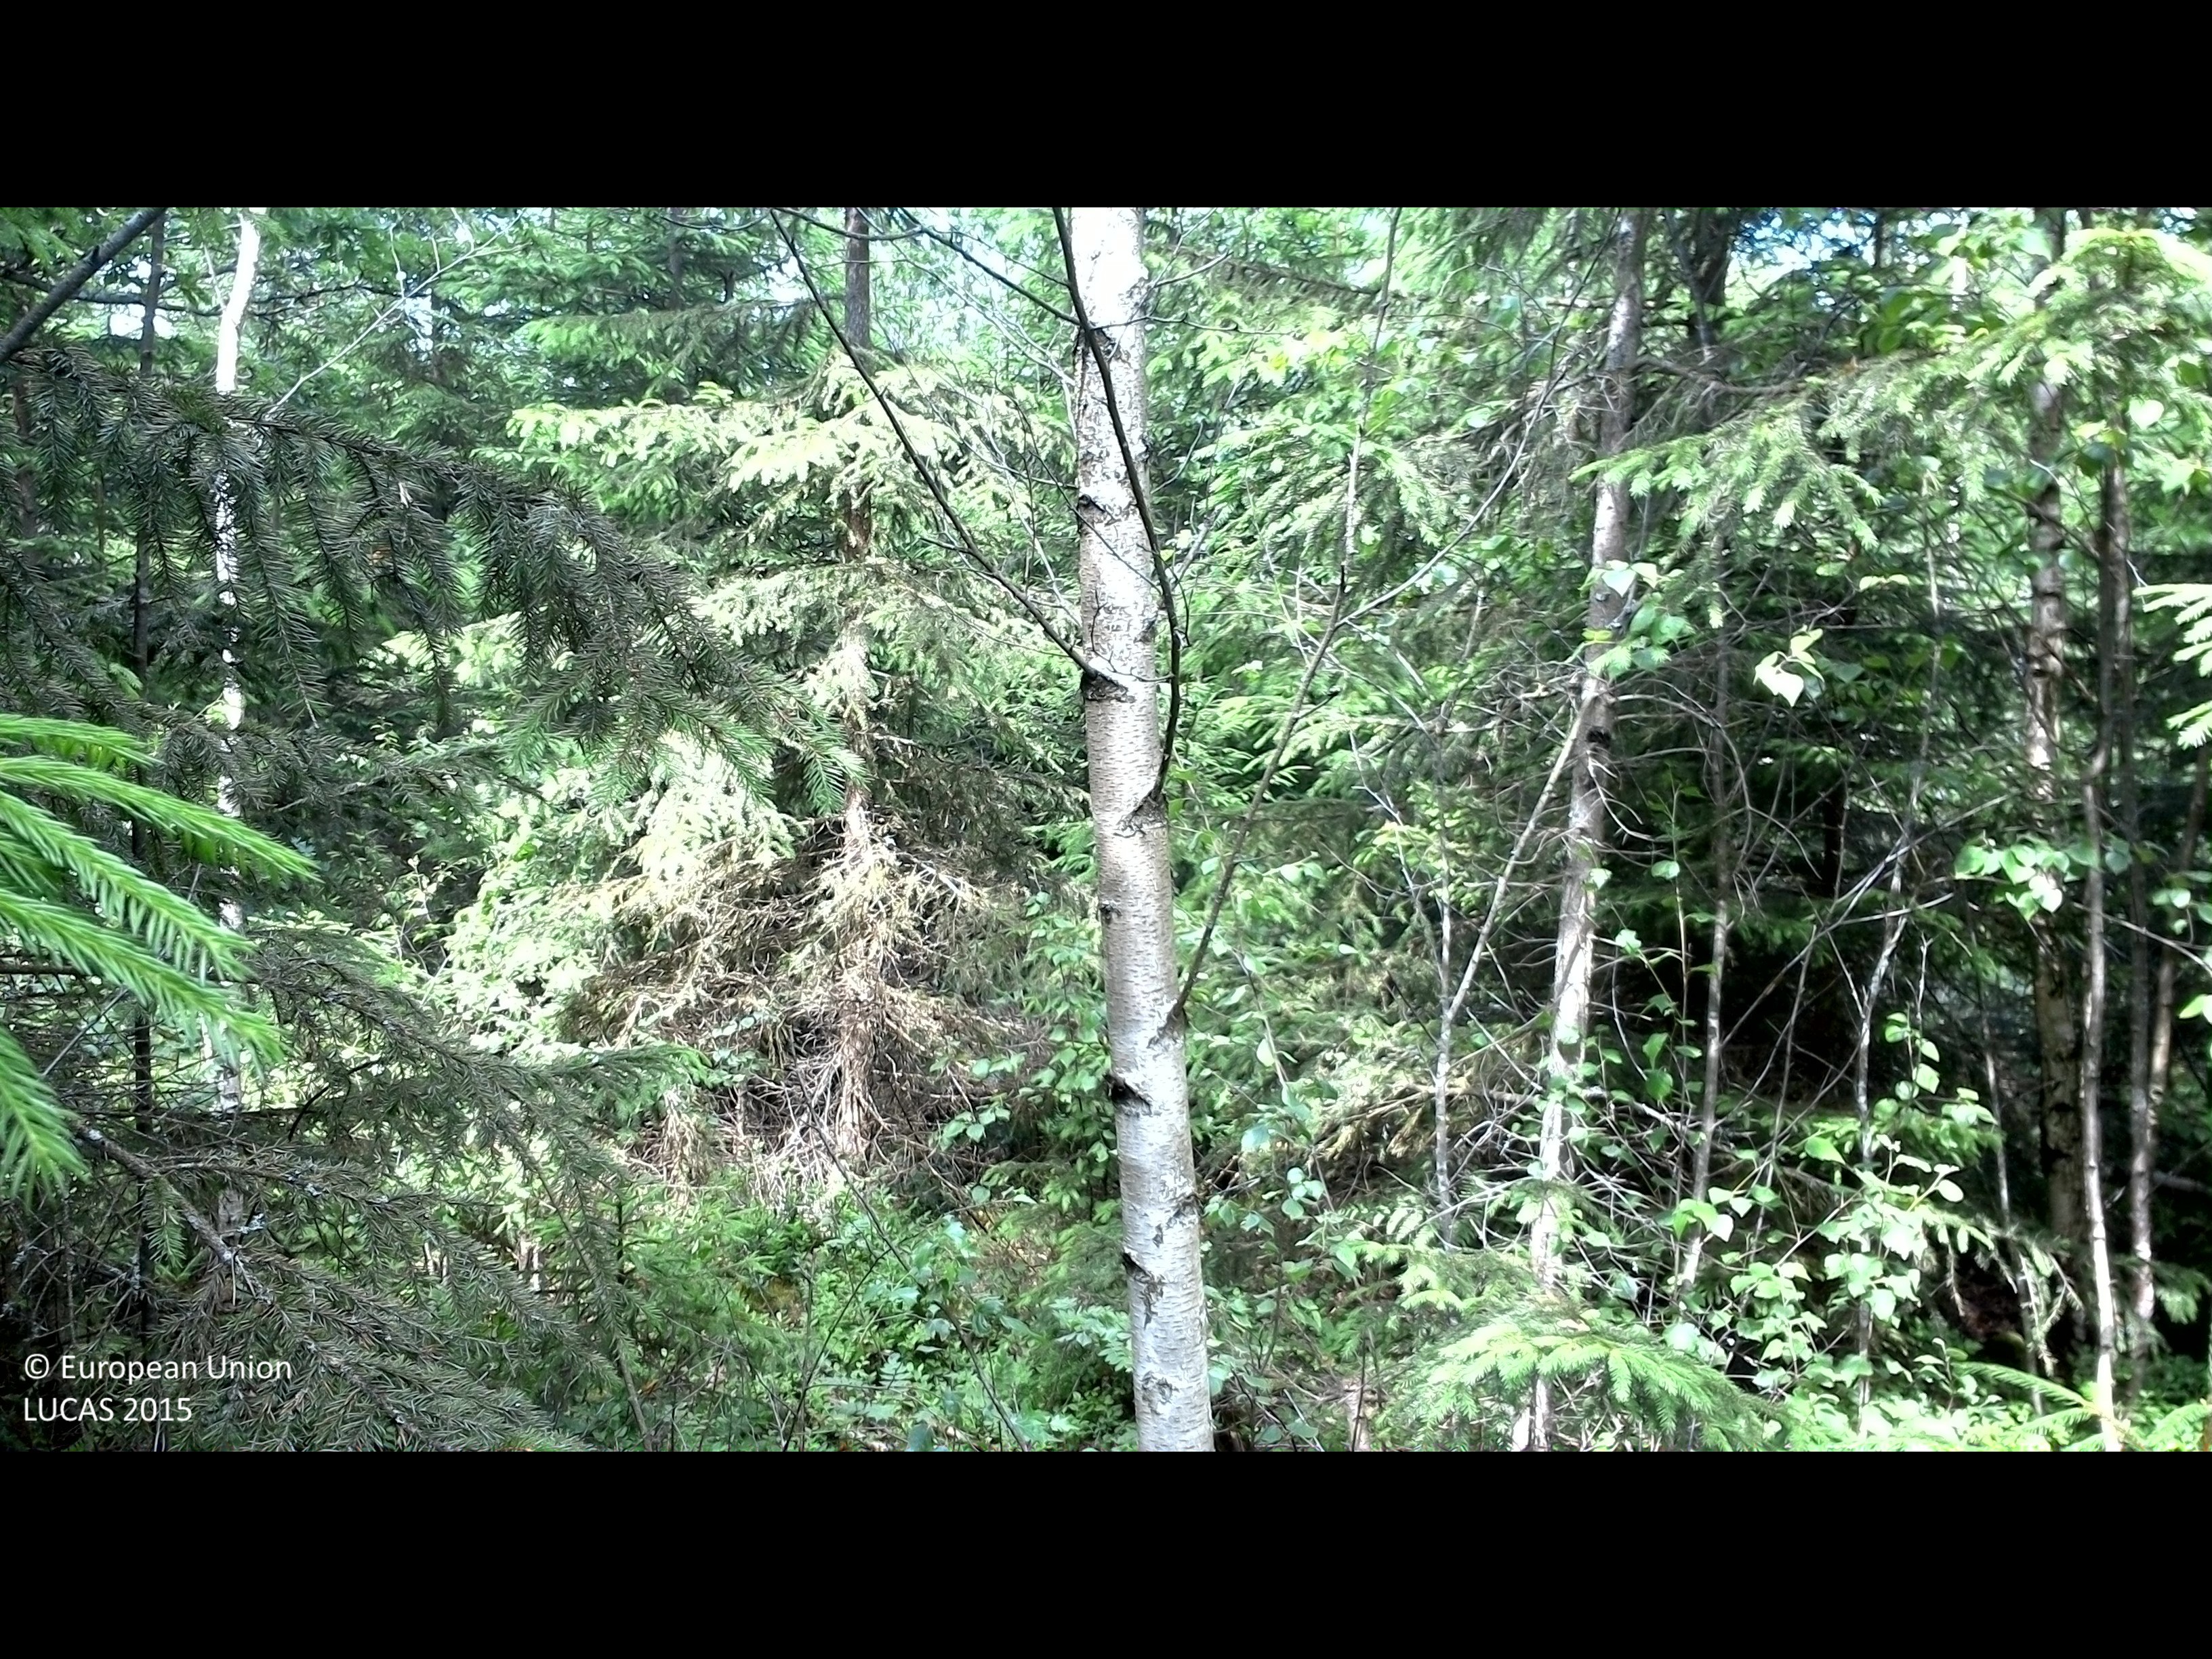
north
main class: Woodland
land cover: Spruce dominated coniferous woodland
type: boreal forest
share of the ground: > 75 %
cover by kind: coniferous forest trees 75 %, shrubs 10 %, broadleaved forest trees 5 %, herbaceous plants 5 %, lichens and mosses 5 %
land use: Forestry
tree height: > 5 m
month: July
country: SE
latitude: 56.3543
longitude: 15.1611
